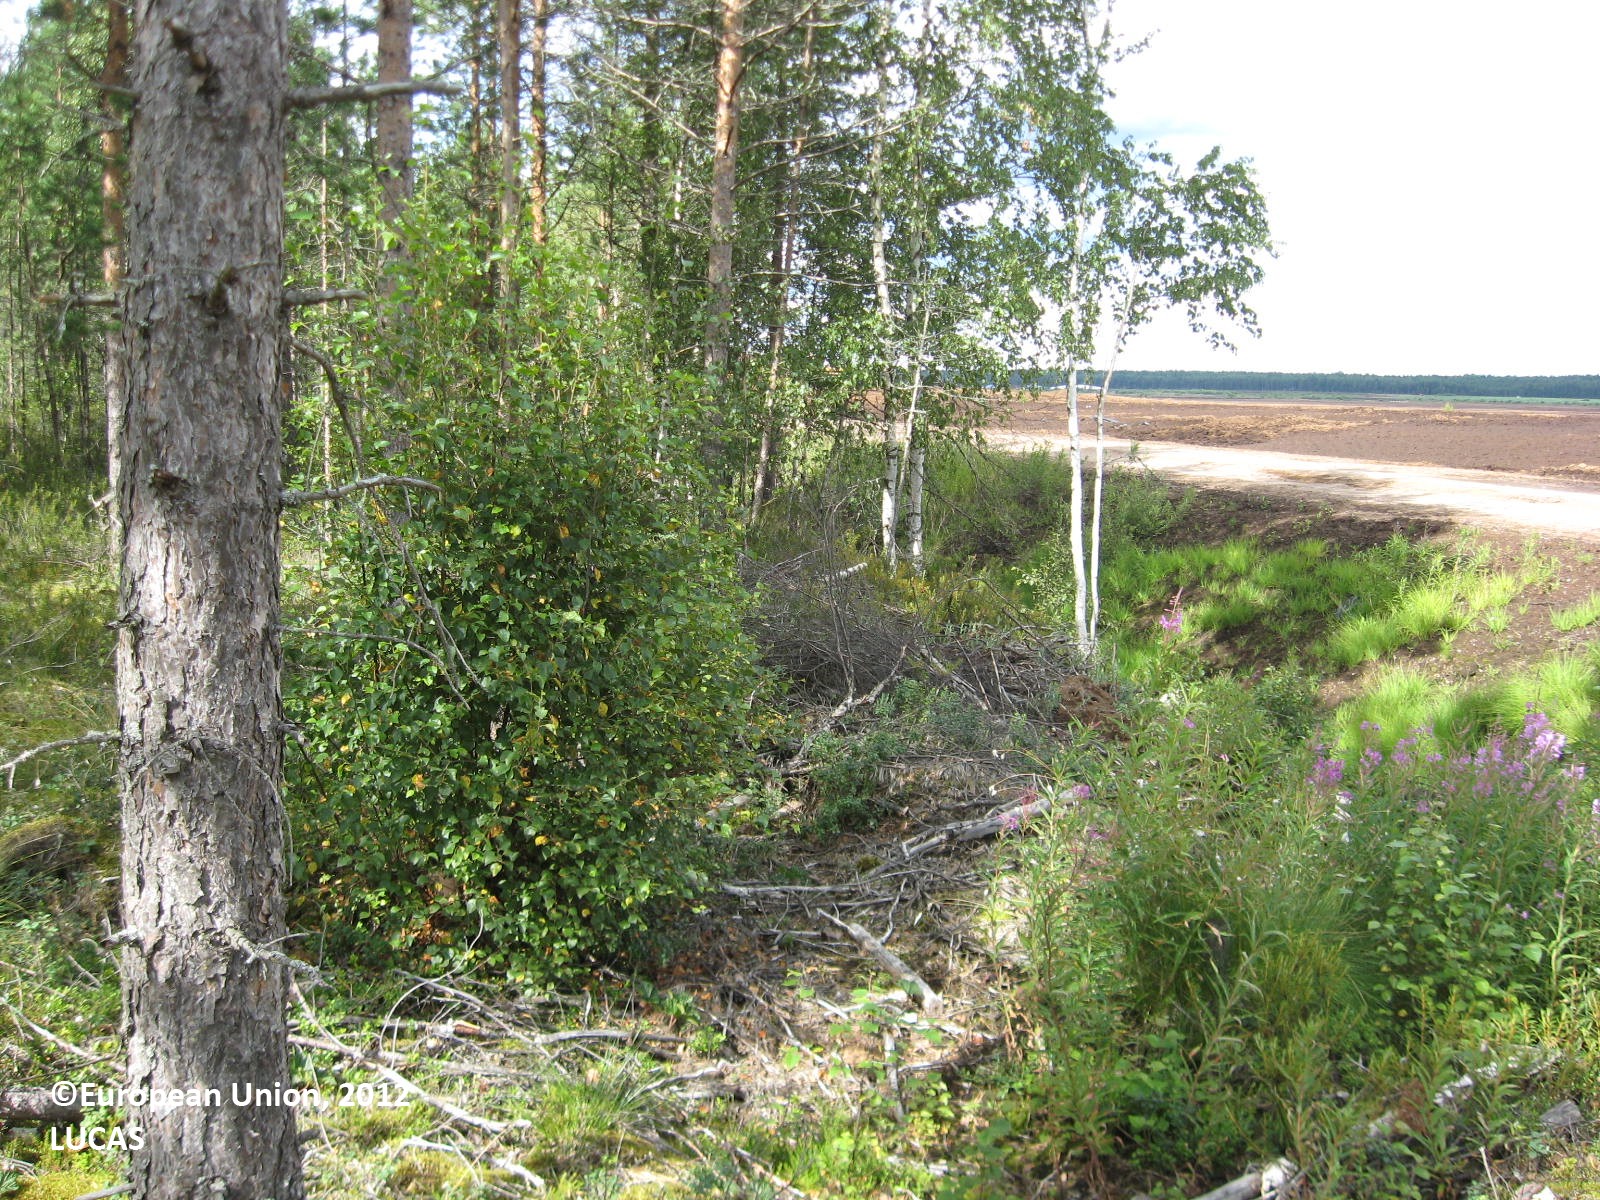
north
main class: Woodland
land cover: Pine dominated coniferous woodland
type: boreal forest
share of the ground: > 75 %
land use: Forestry
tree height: > 5 m
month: July
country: FI
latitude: 61.9903
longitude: 22.3695
